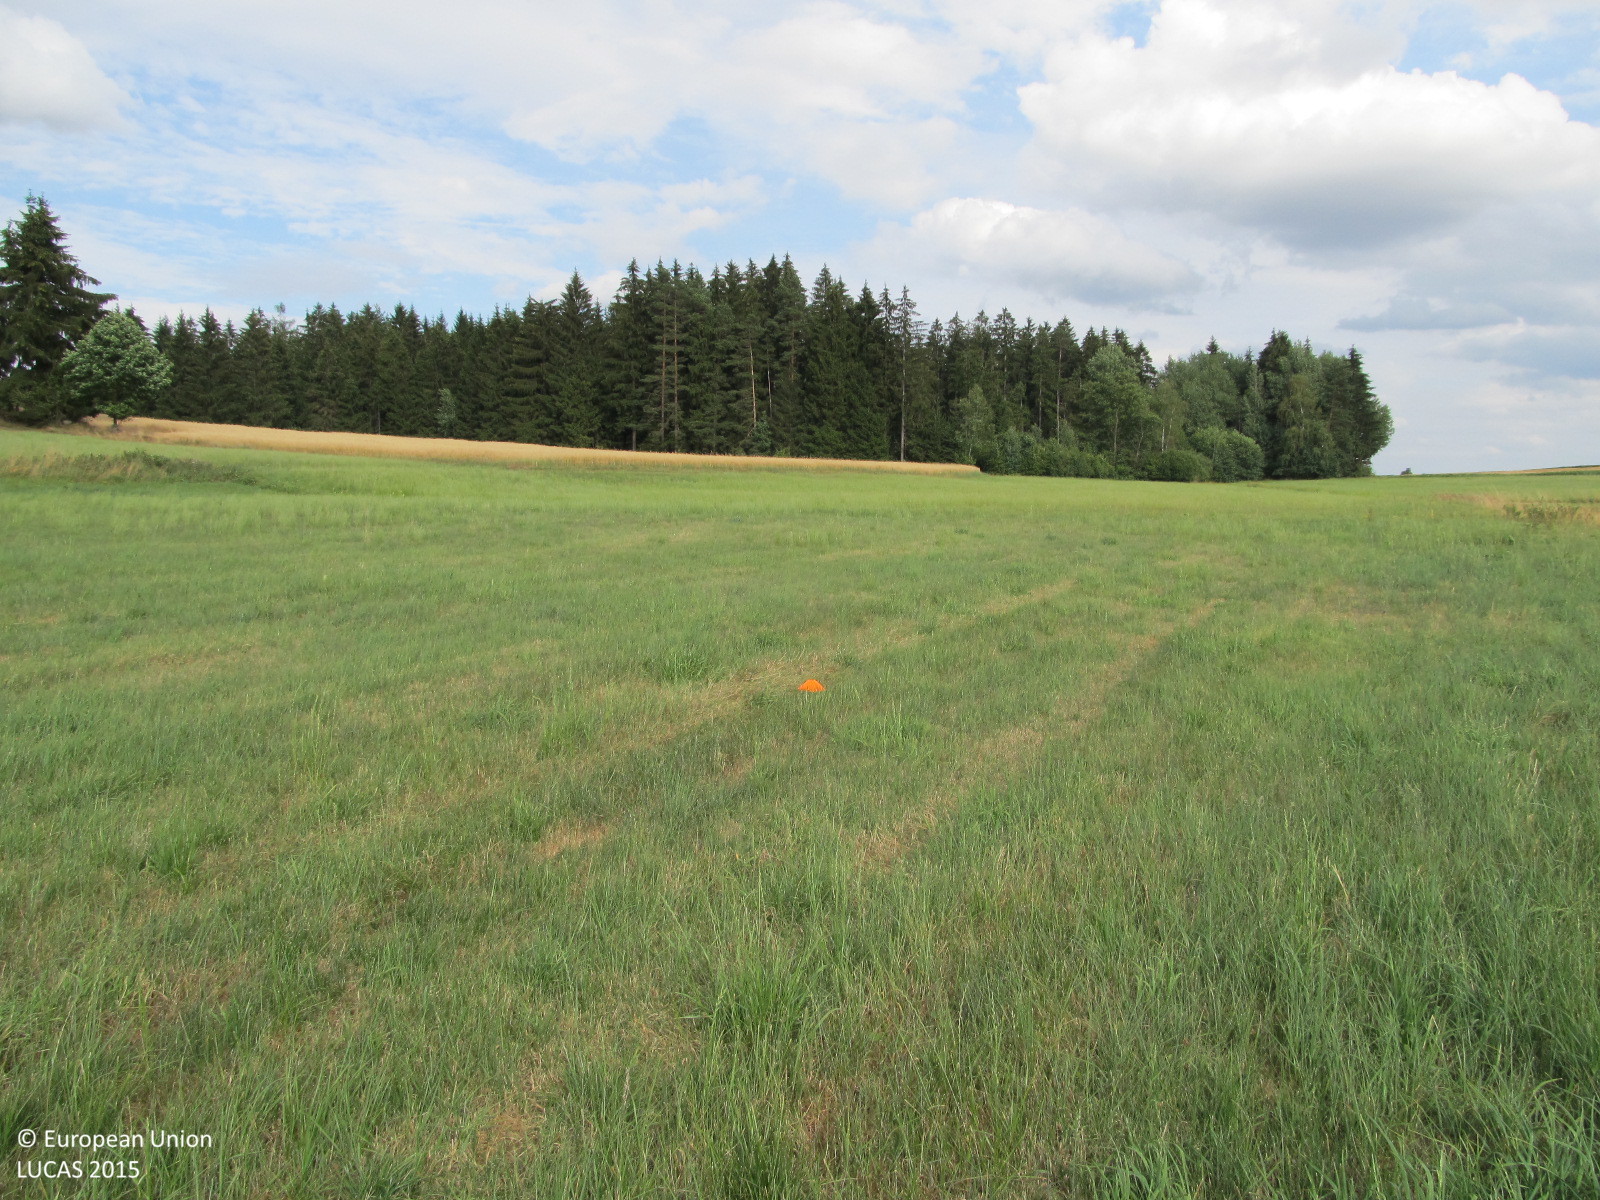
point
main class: Grassland
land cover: Grassland without tree/shrub cover
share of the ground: > 75 %
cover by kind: herbaceous plants 100 %
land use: Agriculture (excluding fallow land and kitchen gardens)
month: July
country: AT
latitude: 48.7031
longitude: 15.0431
